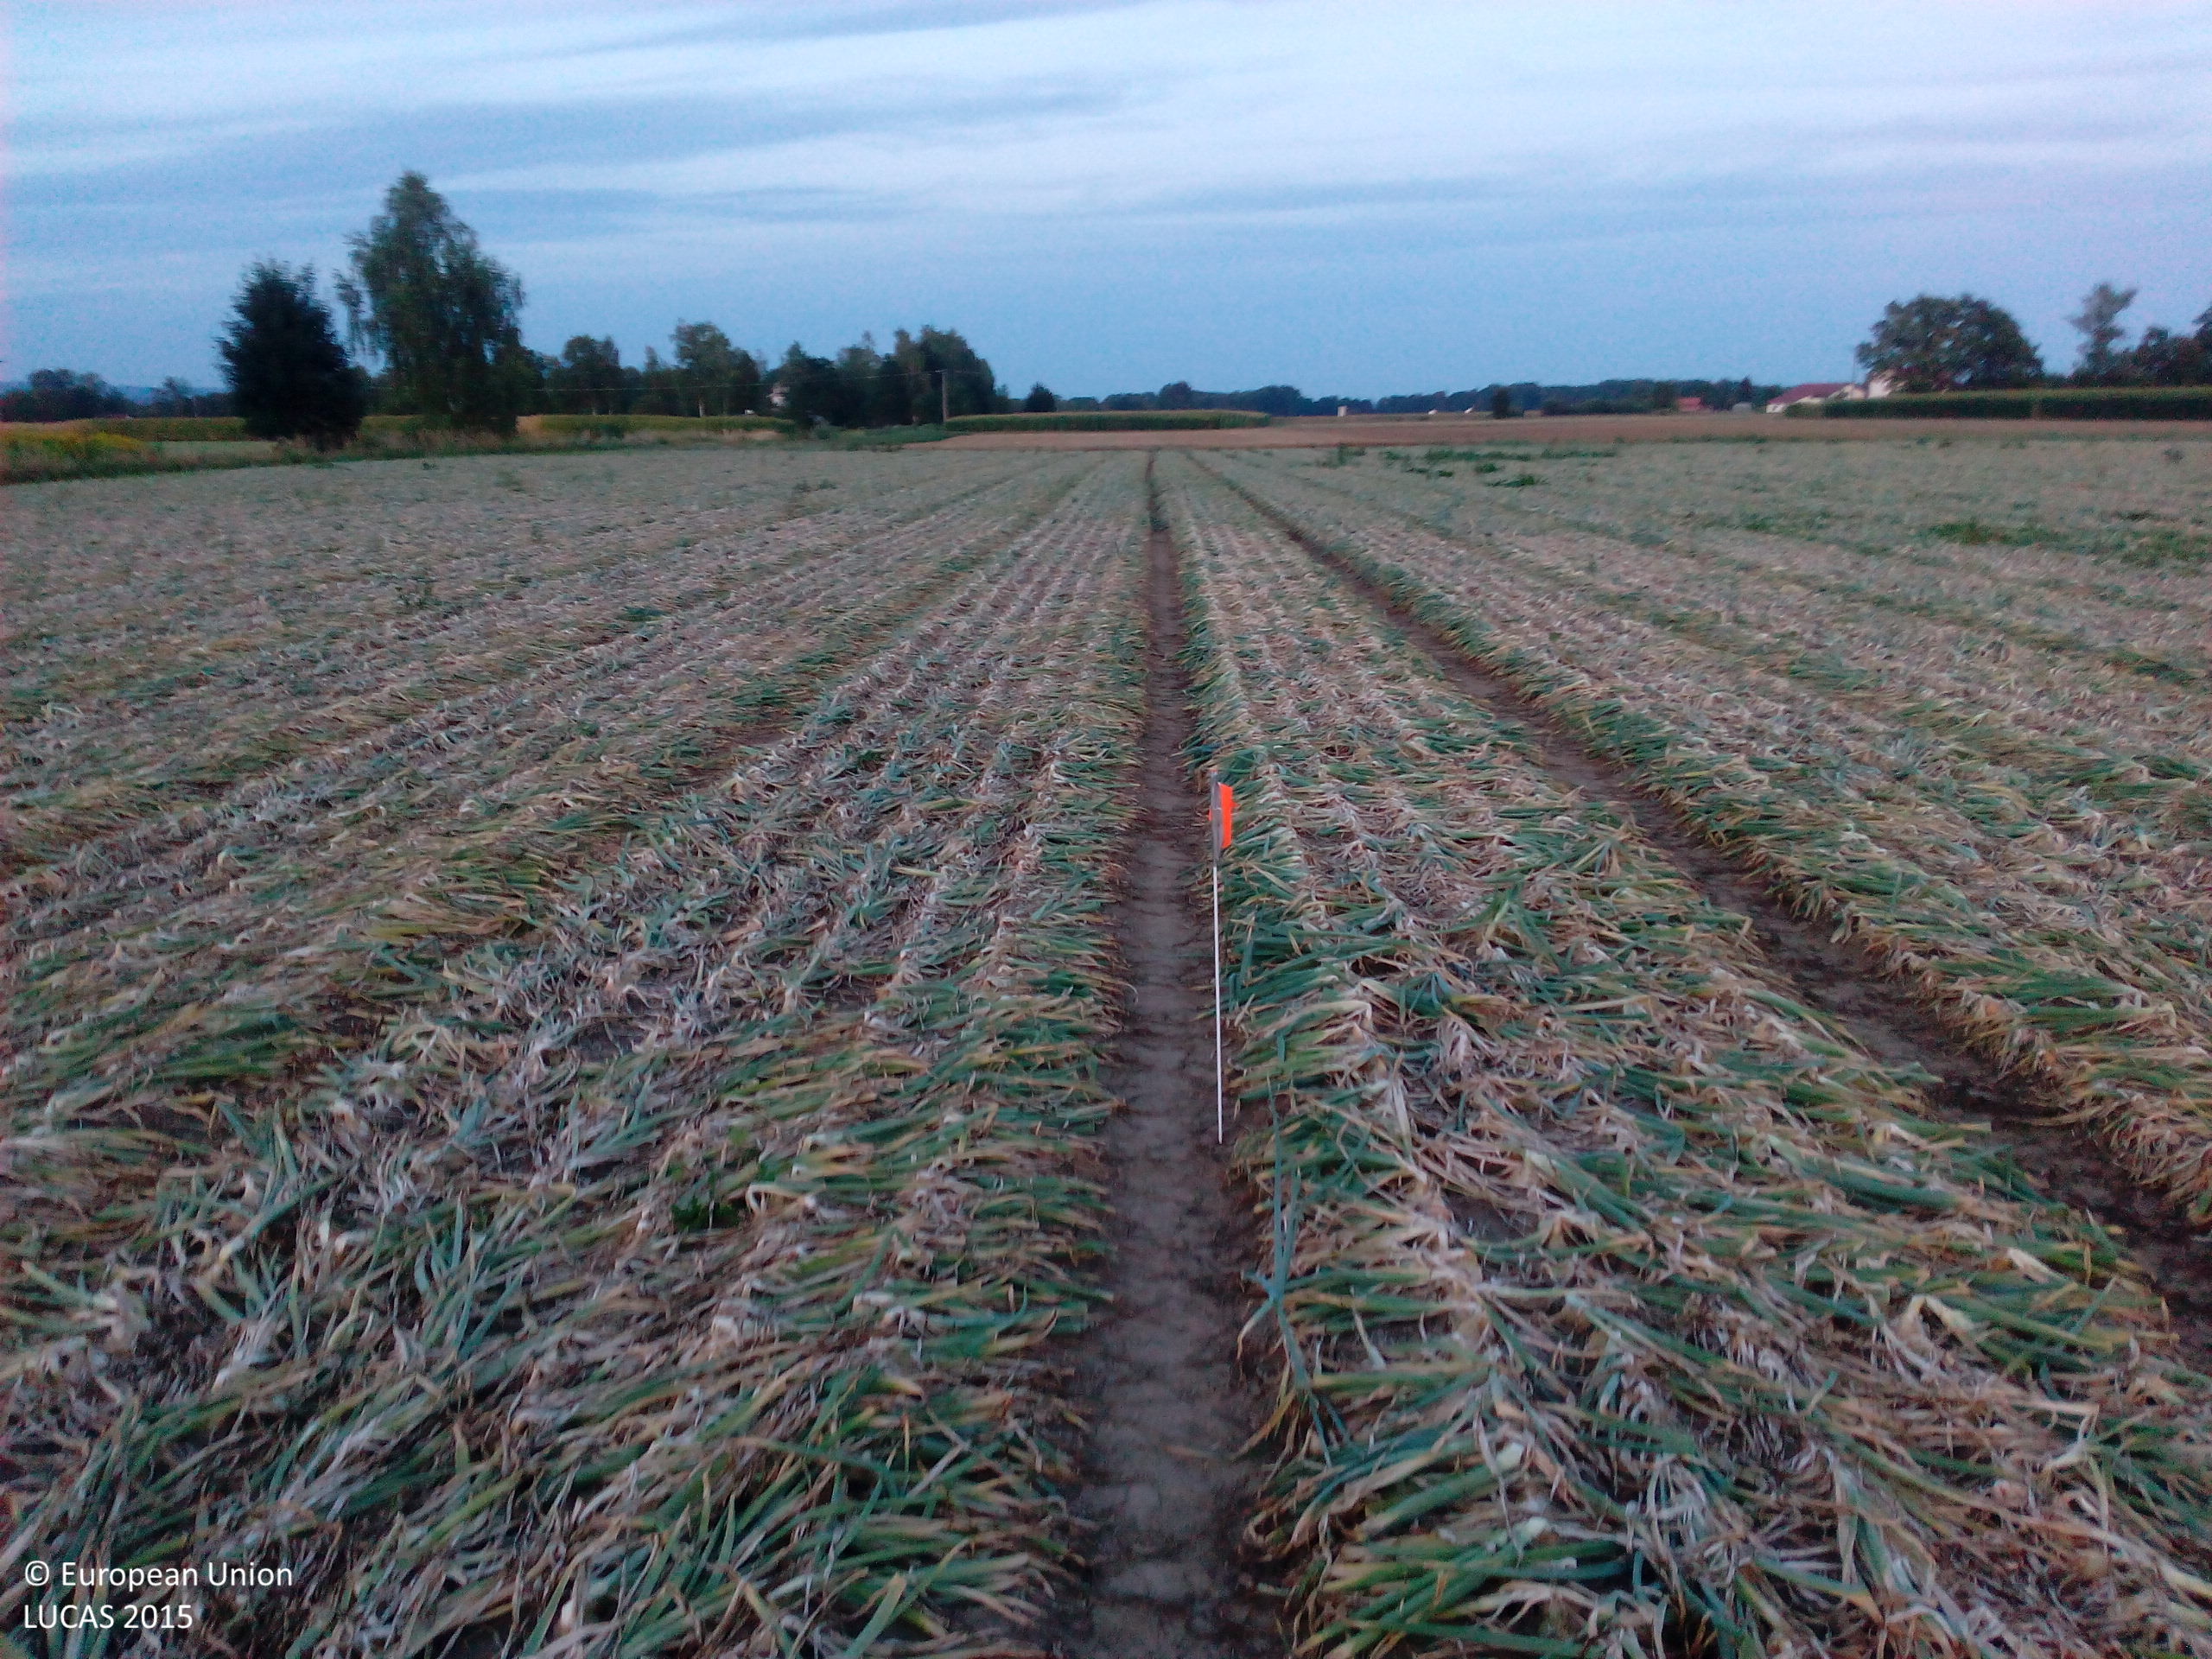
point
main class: Cropland
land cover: Other root crops
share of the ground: 50 - 75 %
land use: Agriculture (excluding fallow land and kitchen gardens)
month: August
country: DE
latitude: 48.7609
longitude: 12.9242
